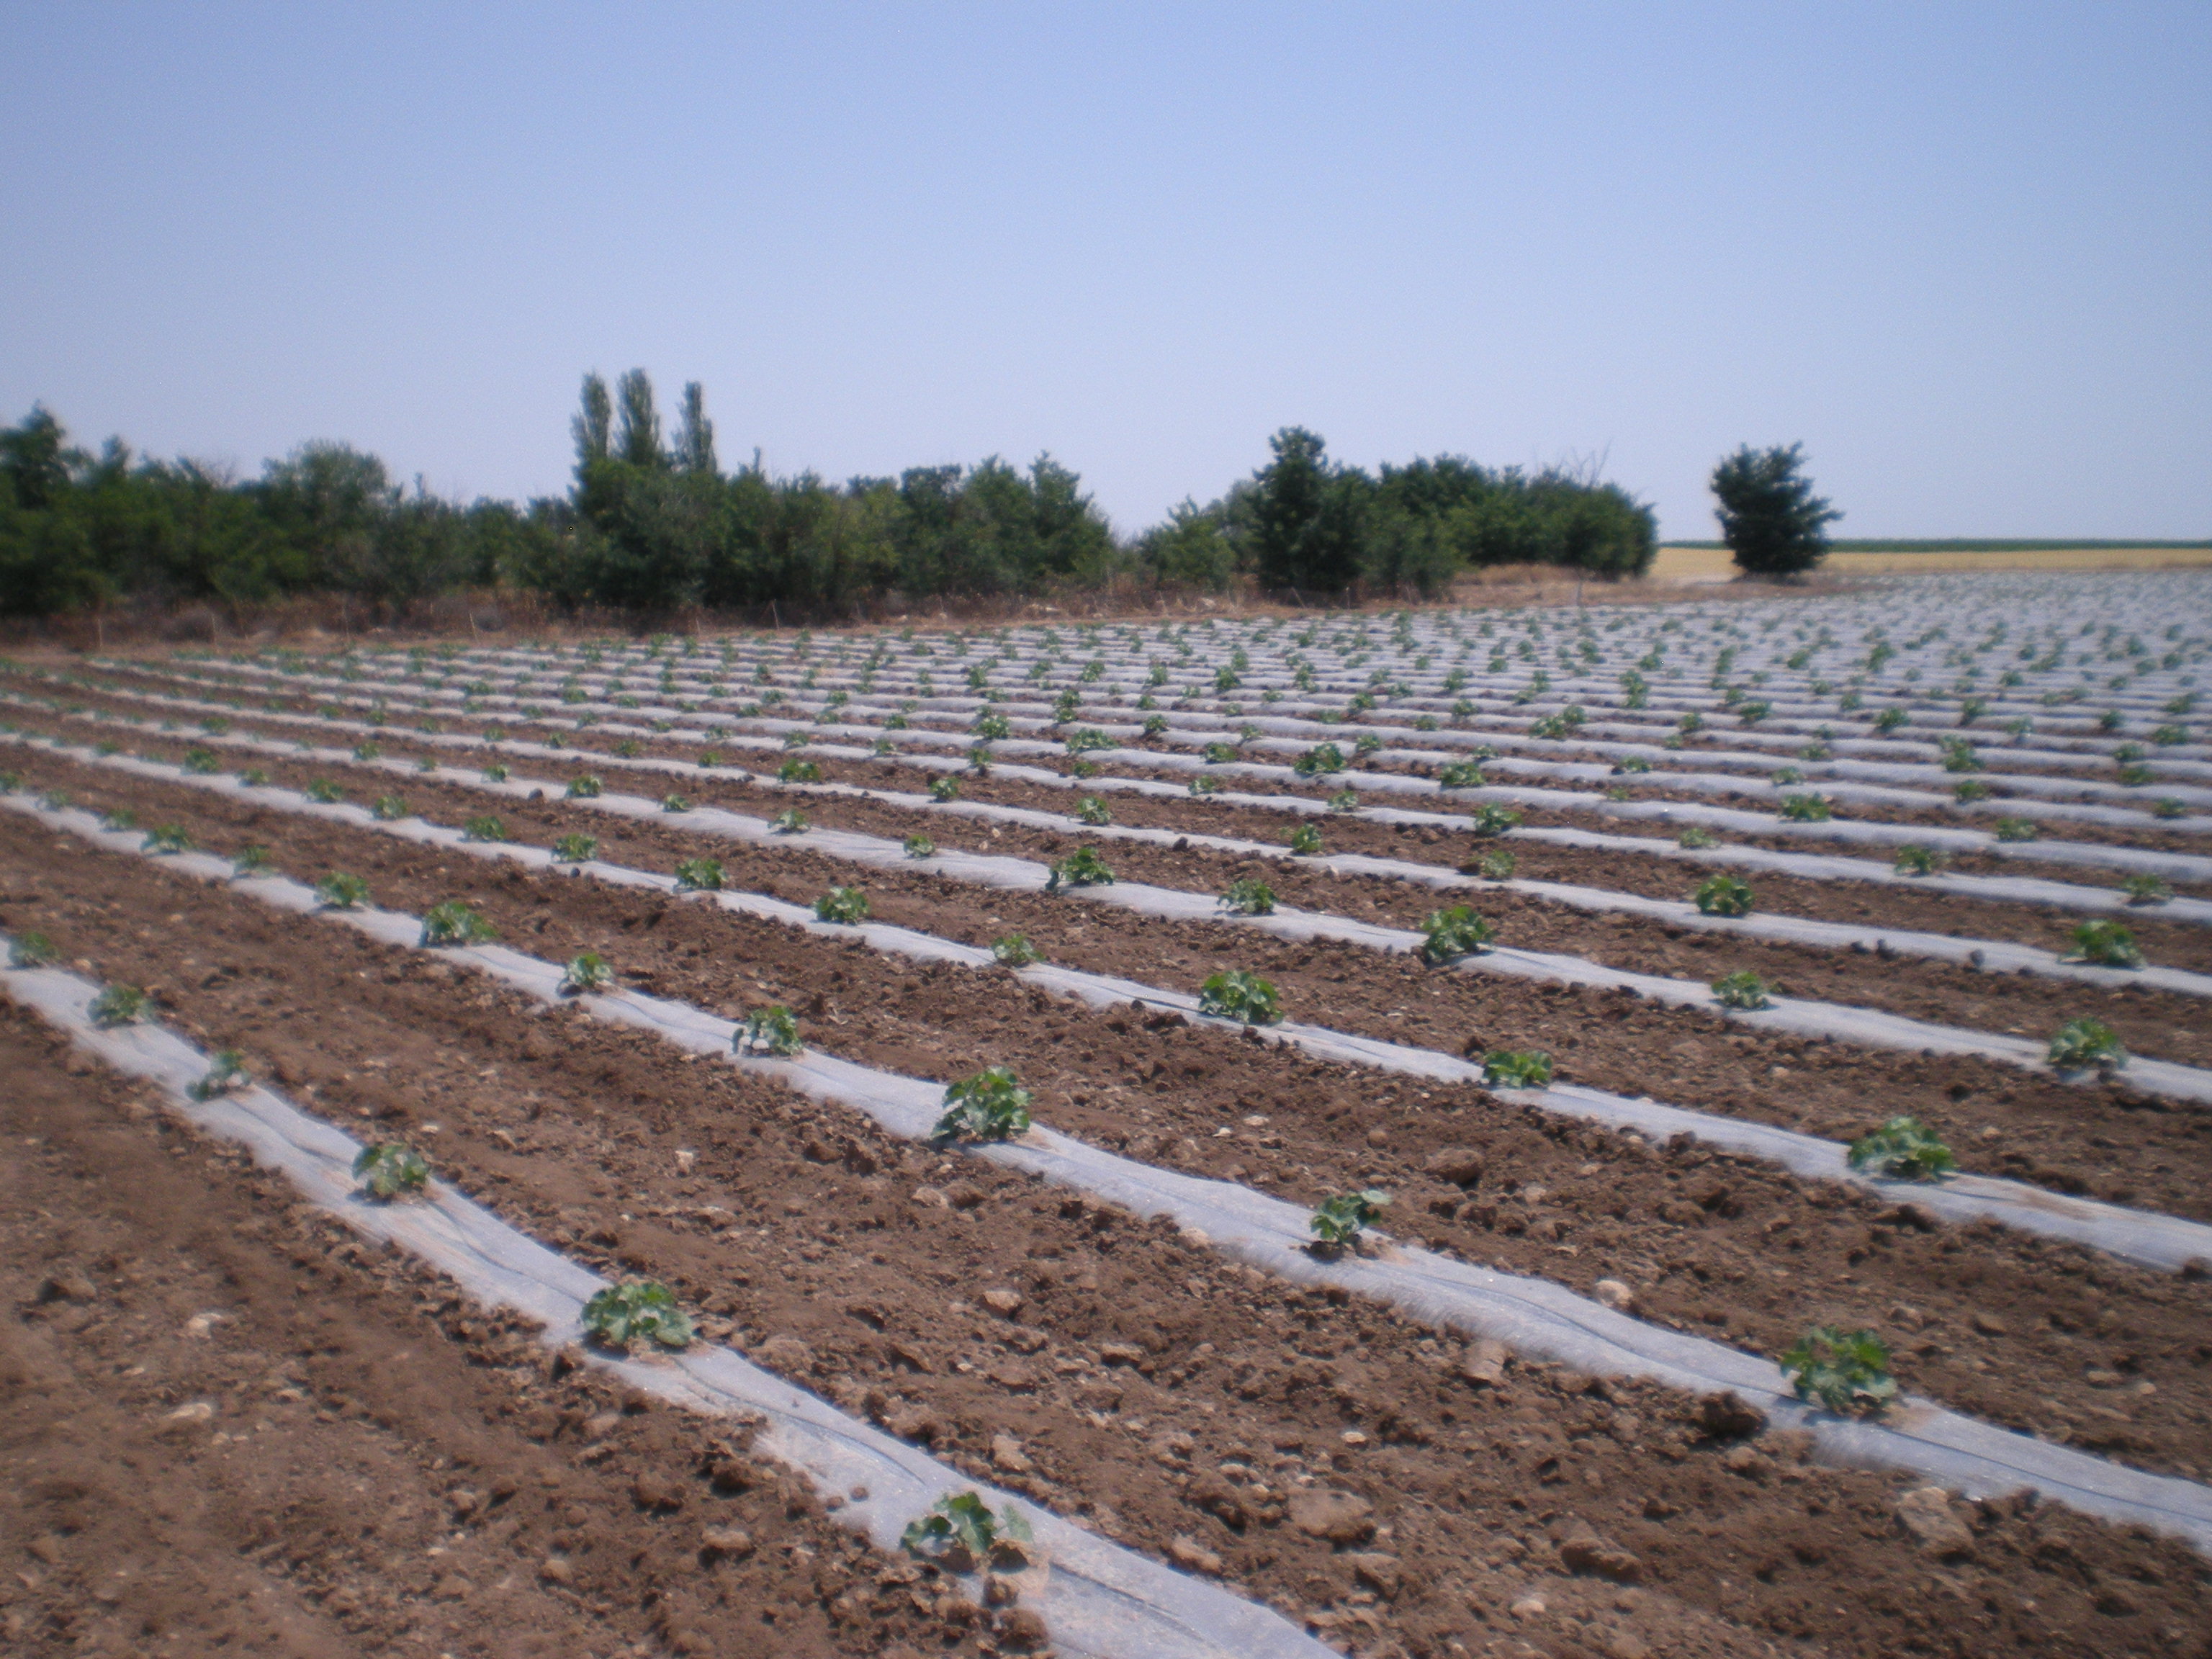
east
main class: Cropland
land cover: Other fresh vegetables
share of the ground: < 10 %
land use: Agriculture (excluding fallow land and kitchen gardens)
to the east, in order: Other fresh vegetables; Fences; Abandoned hedges; Tracks; Abandoned hedges; Fences; Grass margins; Barley; Broadleaved woodland; Rivers and streams; Broadleaved woodland; Grass margins; Tracks; Barley
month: June
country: ES
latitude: 39.6666
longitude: -3.1818
